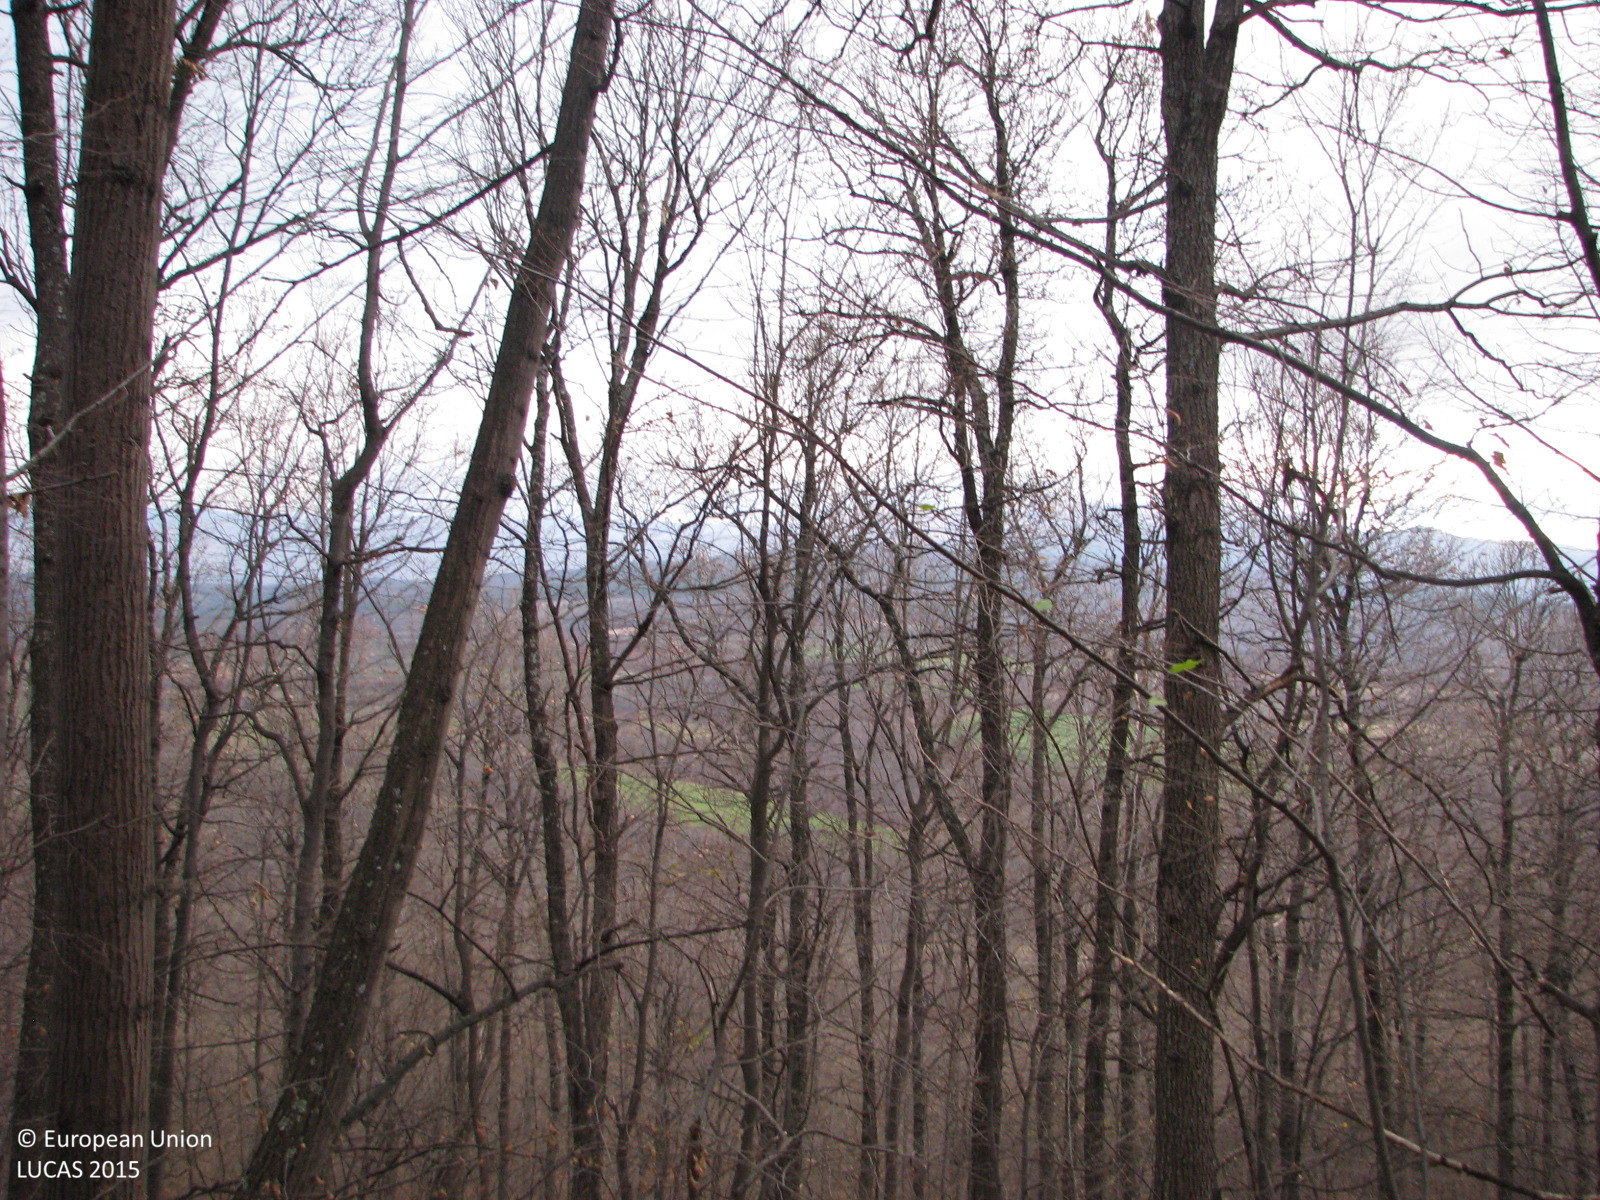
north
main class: Woodland
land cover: Broadleaved woodland
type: mesophytic deciduous forest
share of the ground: > 75 %
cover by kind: broadleaved forest trees 80 %, unconsolidated bare surface 20 %
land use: Forestry
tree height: > 5 m
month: December
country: BG
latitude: 42.4803
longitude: 24.2674
